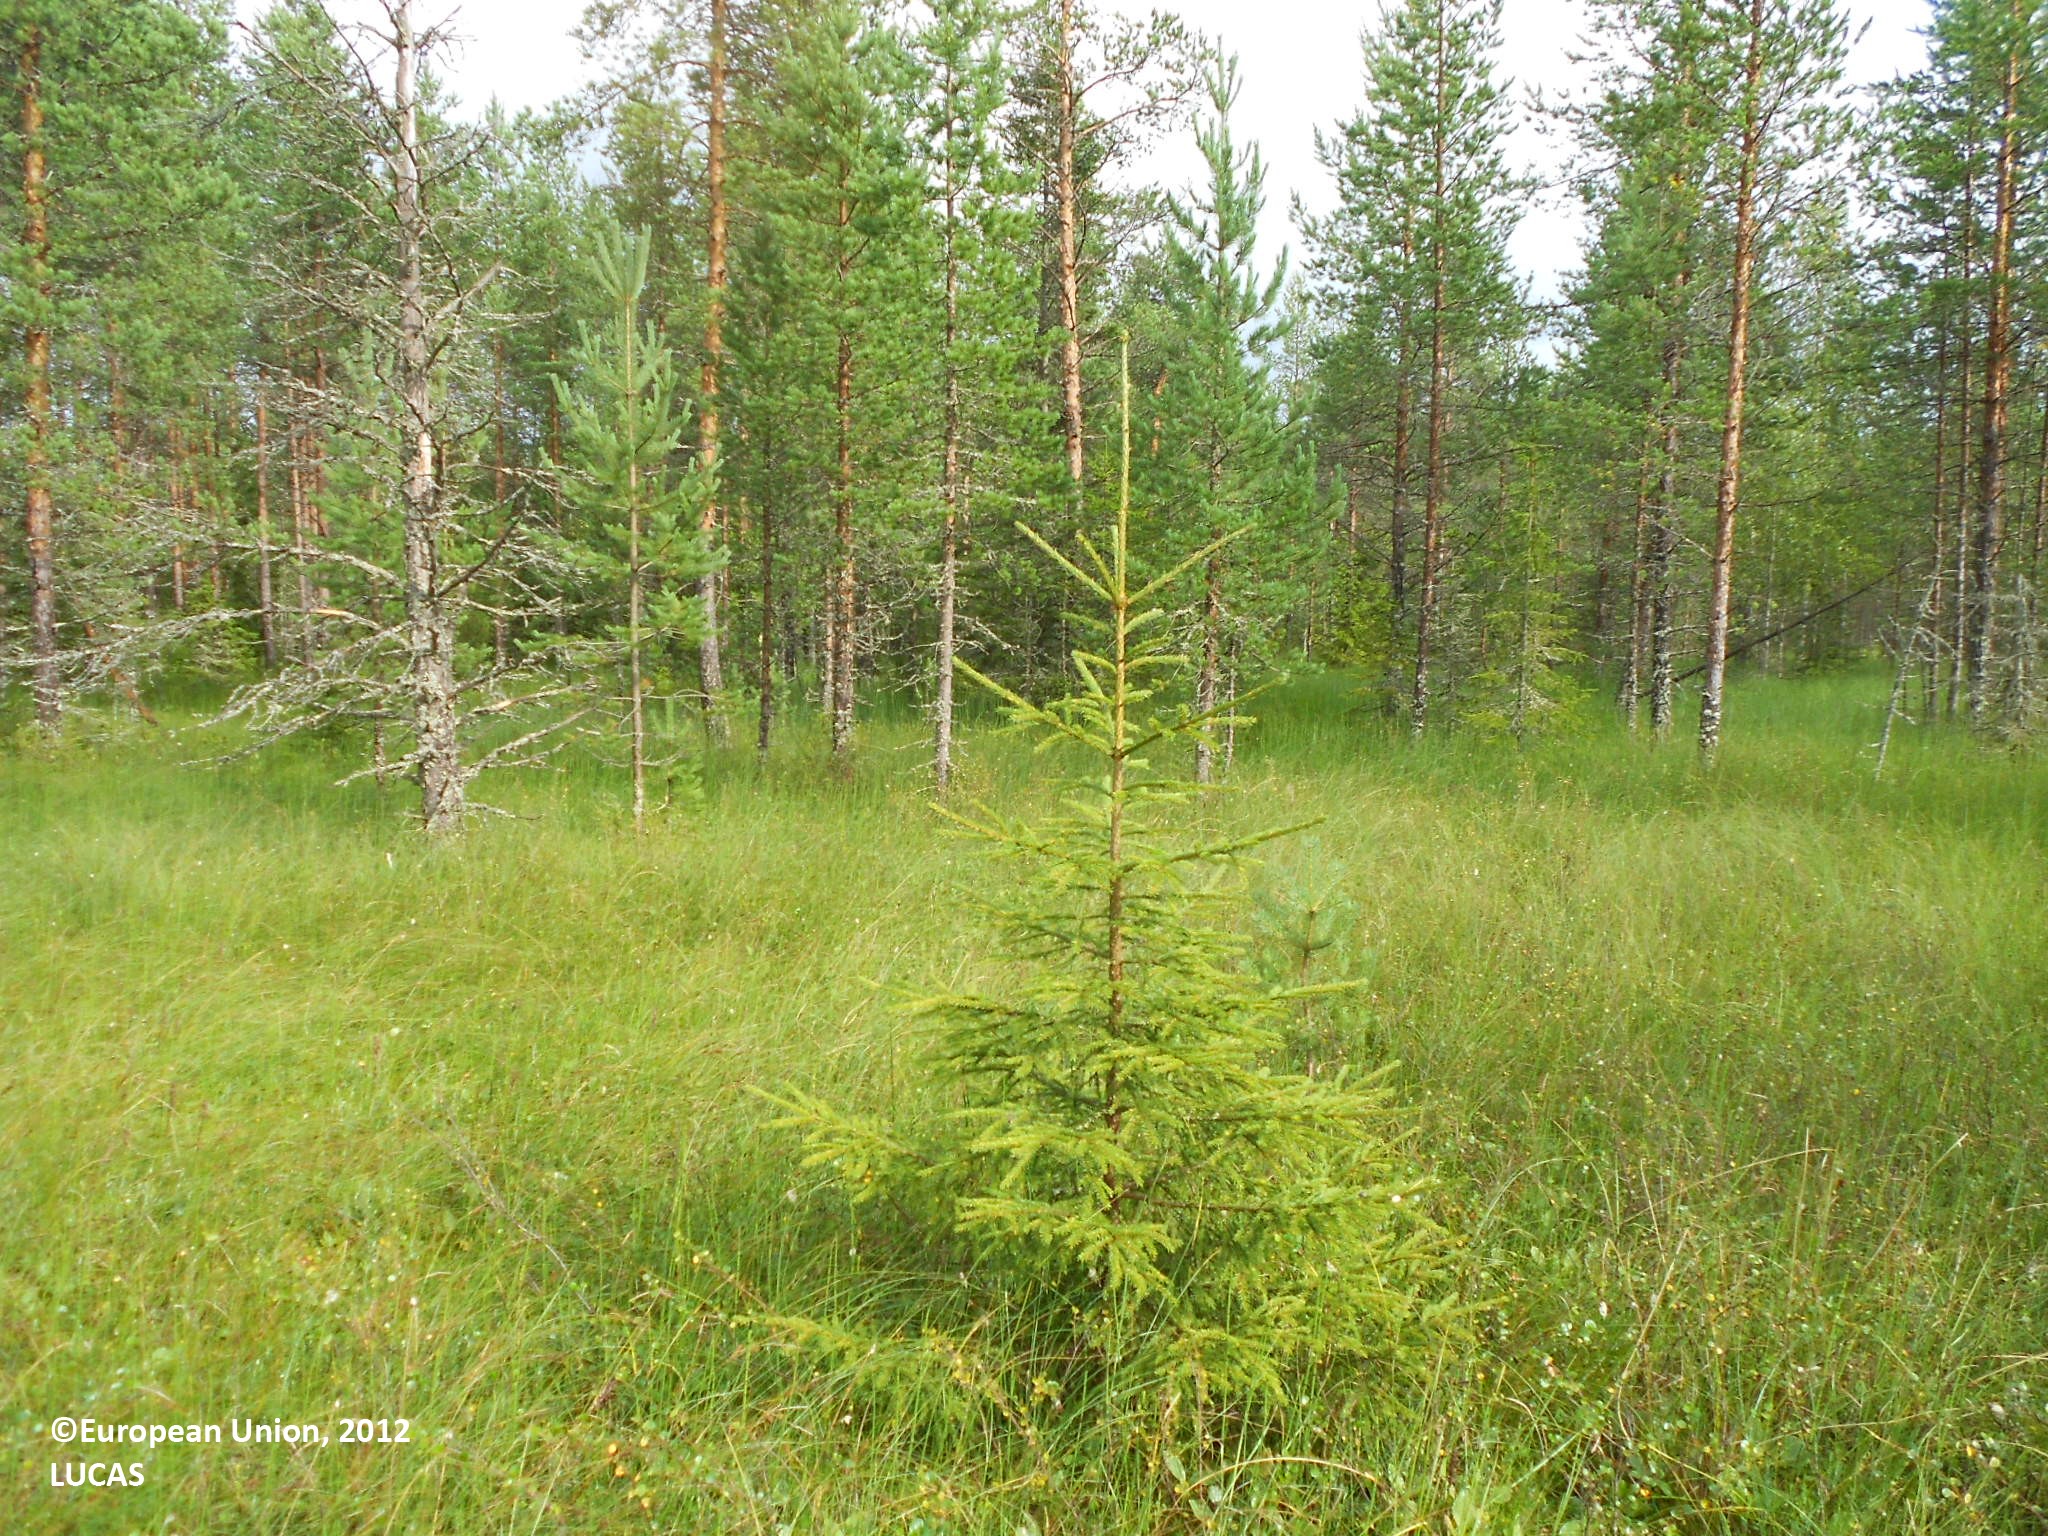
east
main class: Woodland
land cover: Pine dominated coniferous woodland
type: boreal forest
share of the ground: 10 - 25 %
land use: Semi-natural and natural areas not in use
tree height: > 5 m
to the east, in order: Pine dominated coniferous woodland; Peatbogs; Pine dominated coniferous woodland; Peatbogs
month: August
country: FI
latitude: 63.5746
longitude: 28.4958
